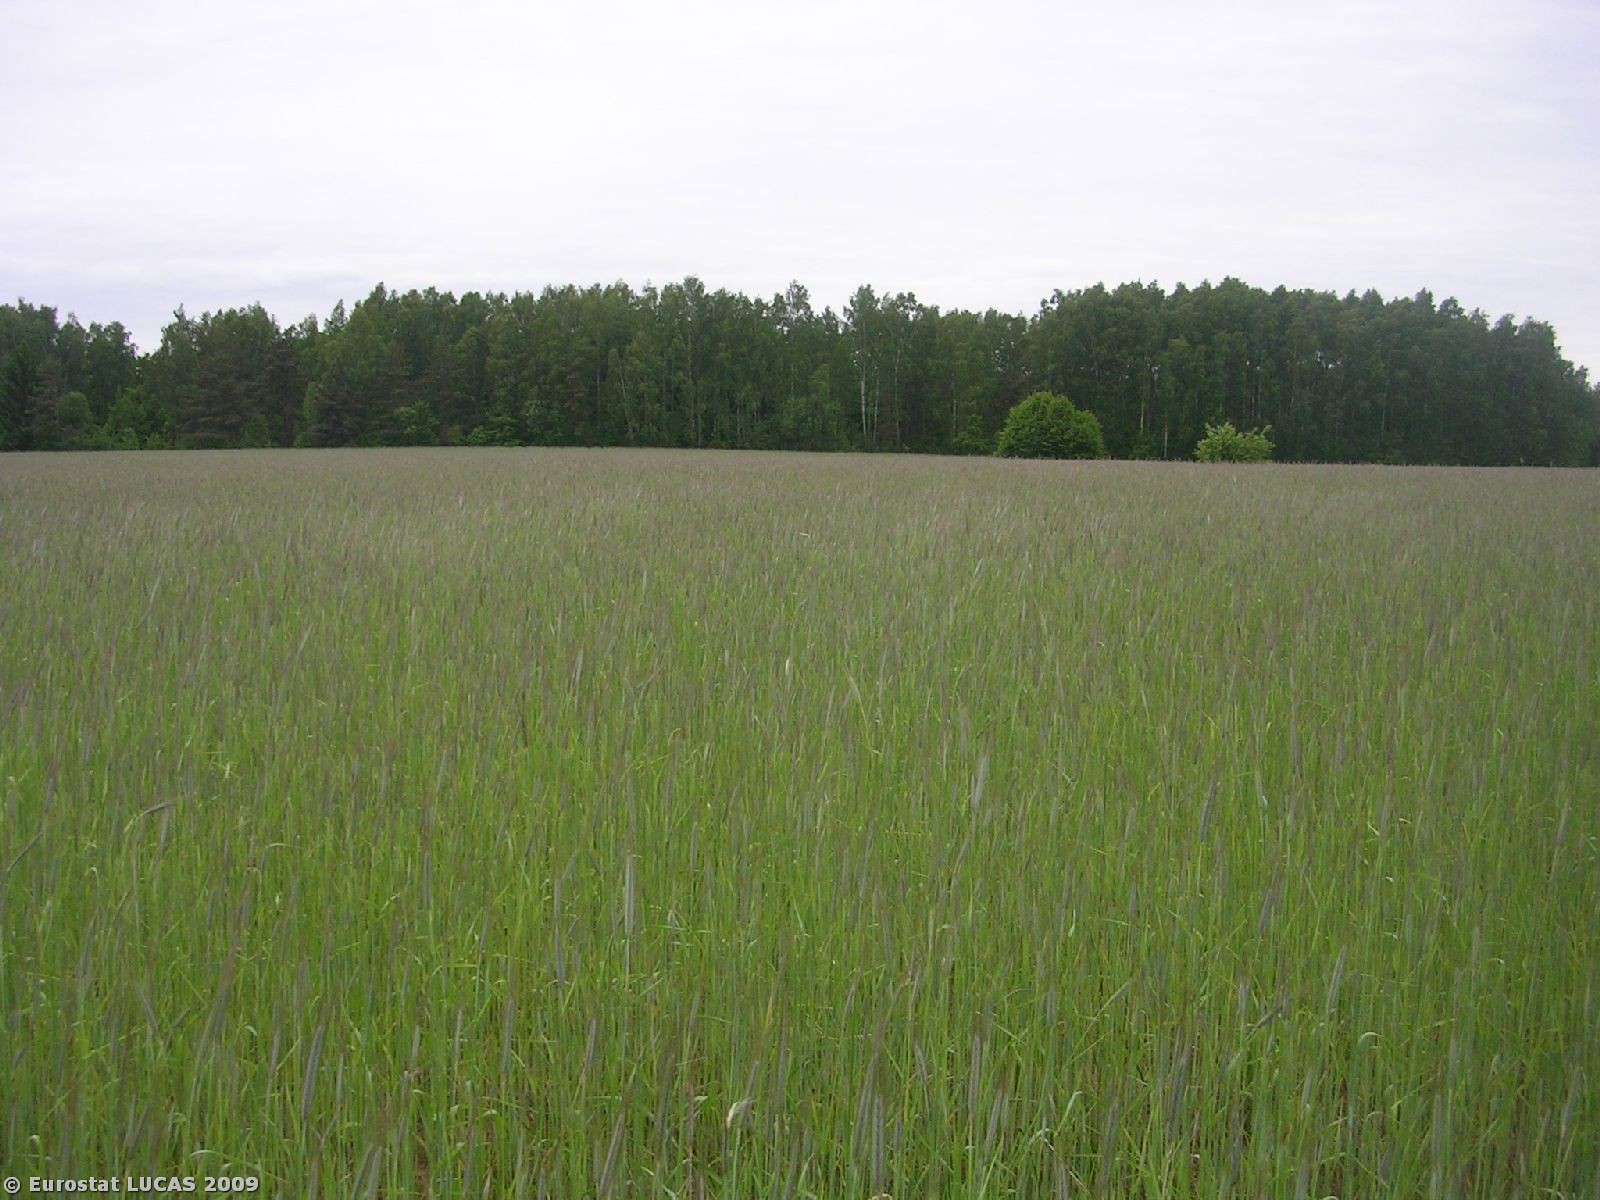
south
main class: Cropland
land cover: Barley
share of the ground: 25 - 50 %
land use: Agriculture (excluding fallow land and kitchen gardens)
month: May
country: PL
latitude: 53.5742
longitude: 23.4784
